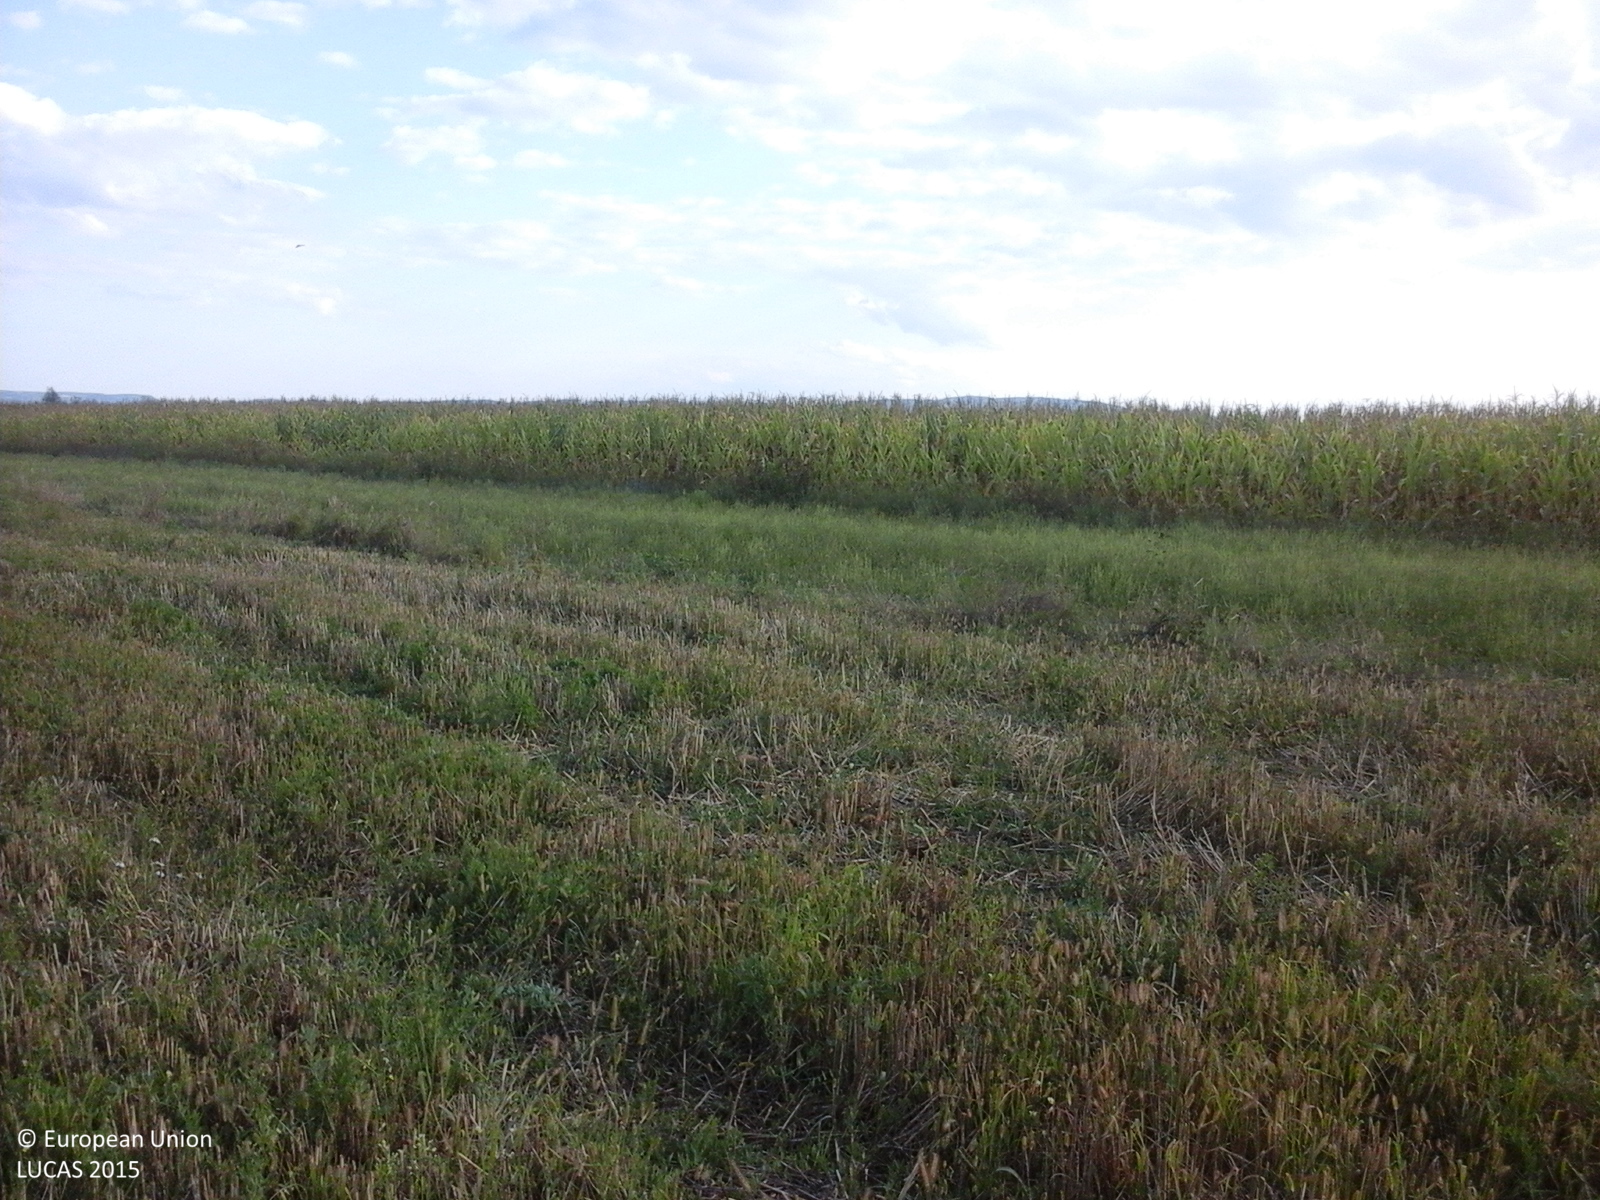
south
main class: Cropland
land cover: Common wheat
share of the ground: 50 - 75 %
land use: Agriculture (excluding fallow land and kitchen gardens)
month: September
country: RO
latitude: 47.5887
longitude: 23.3560
